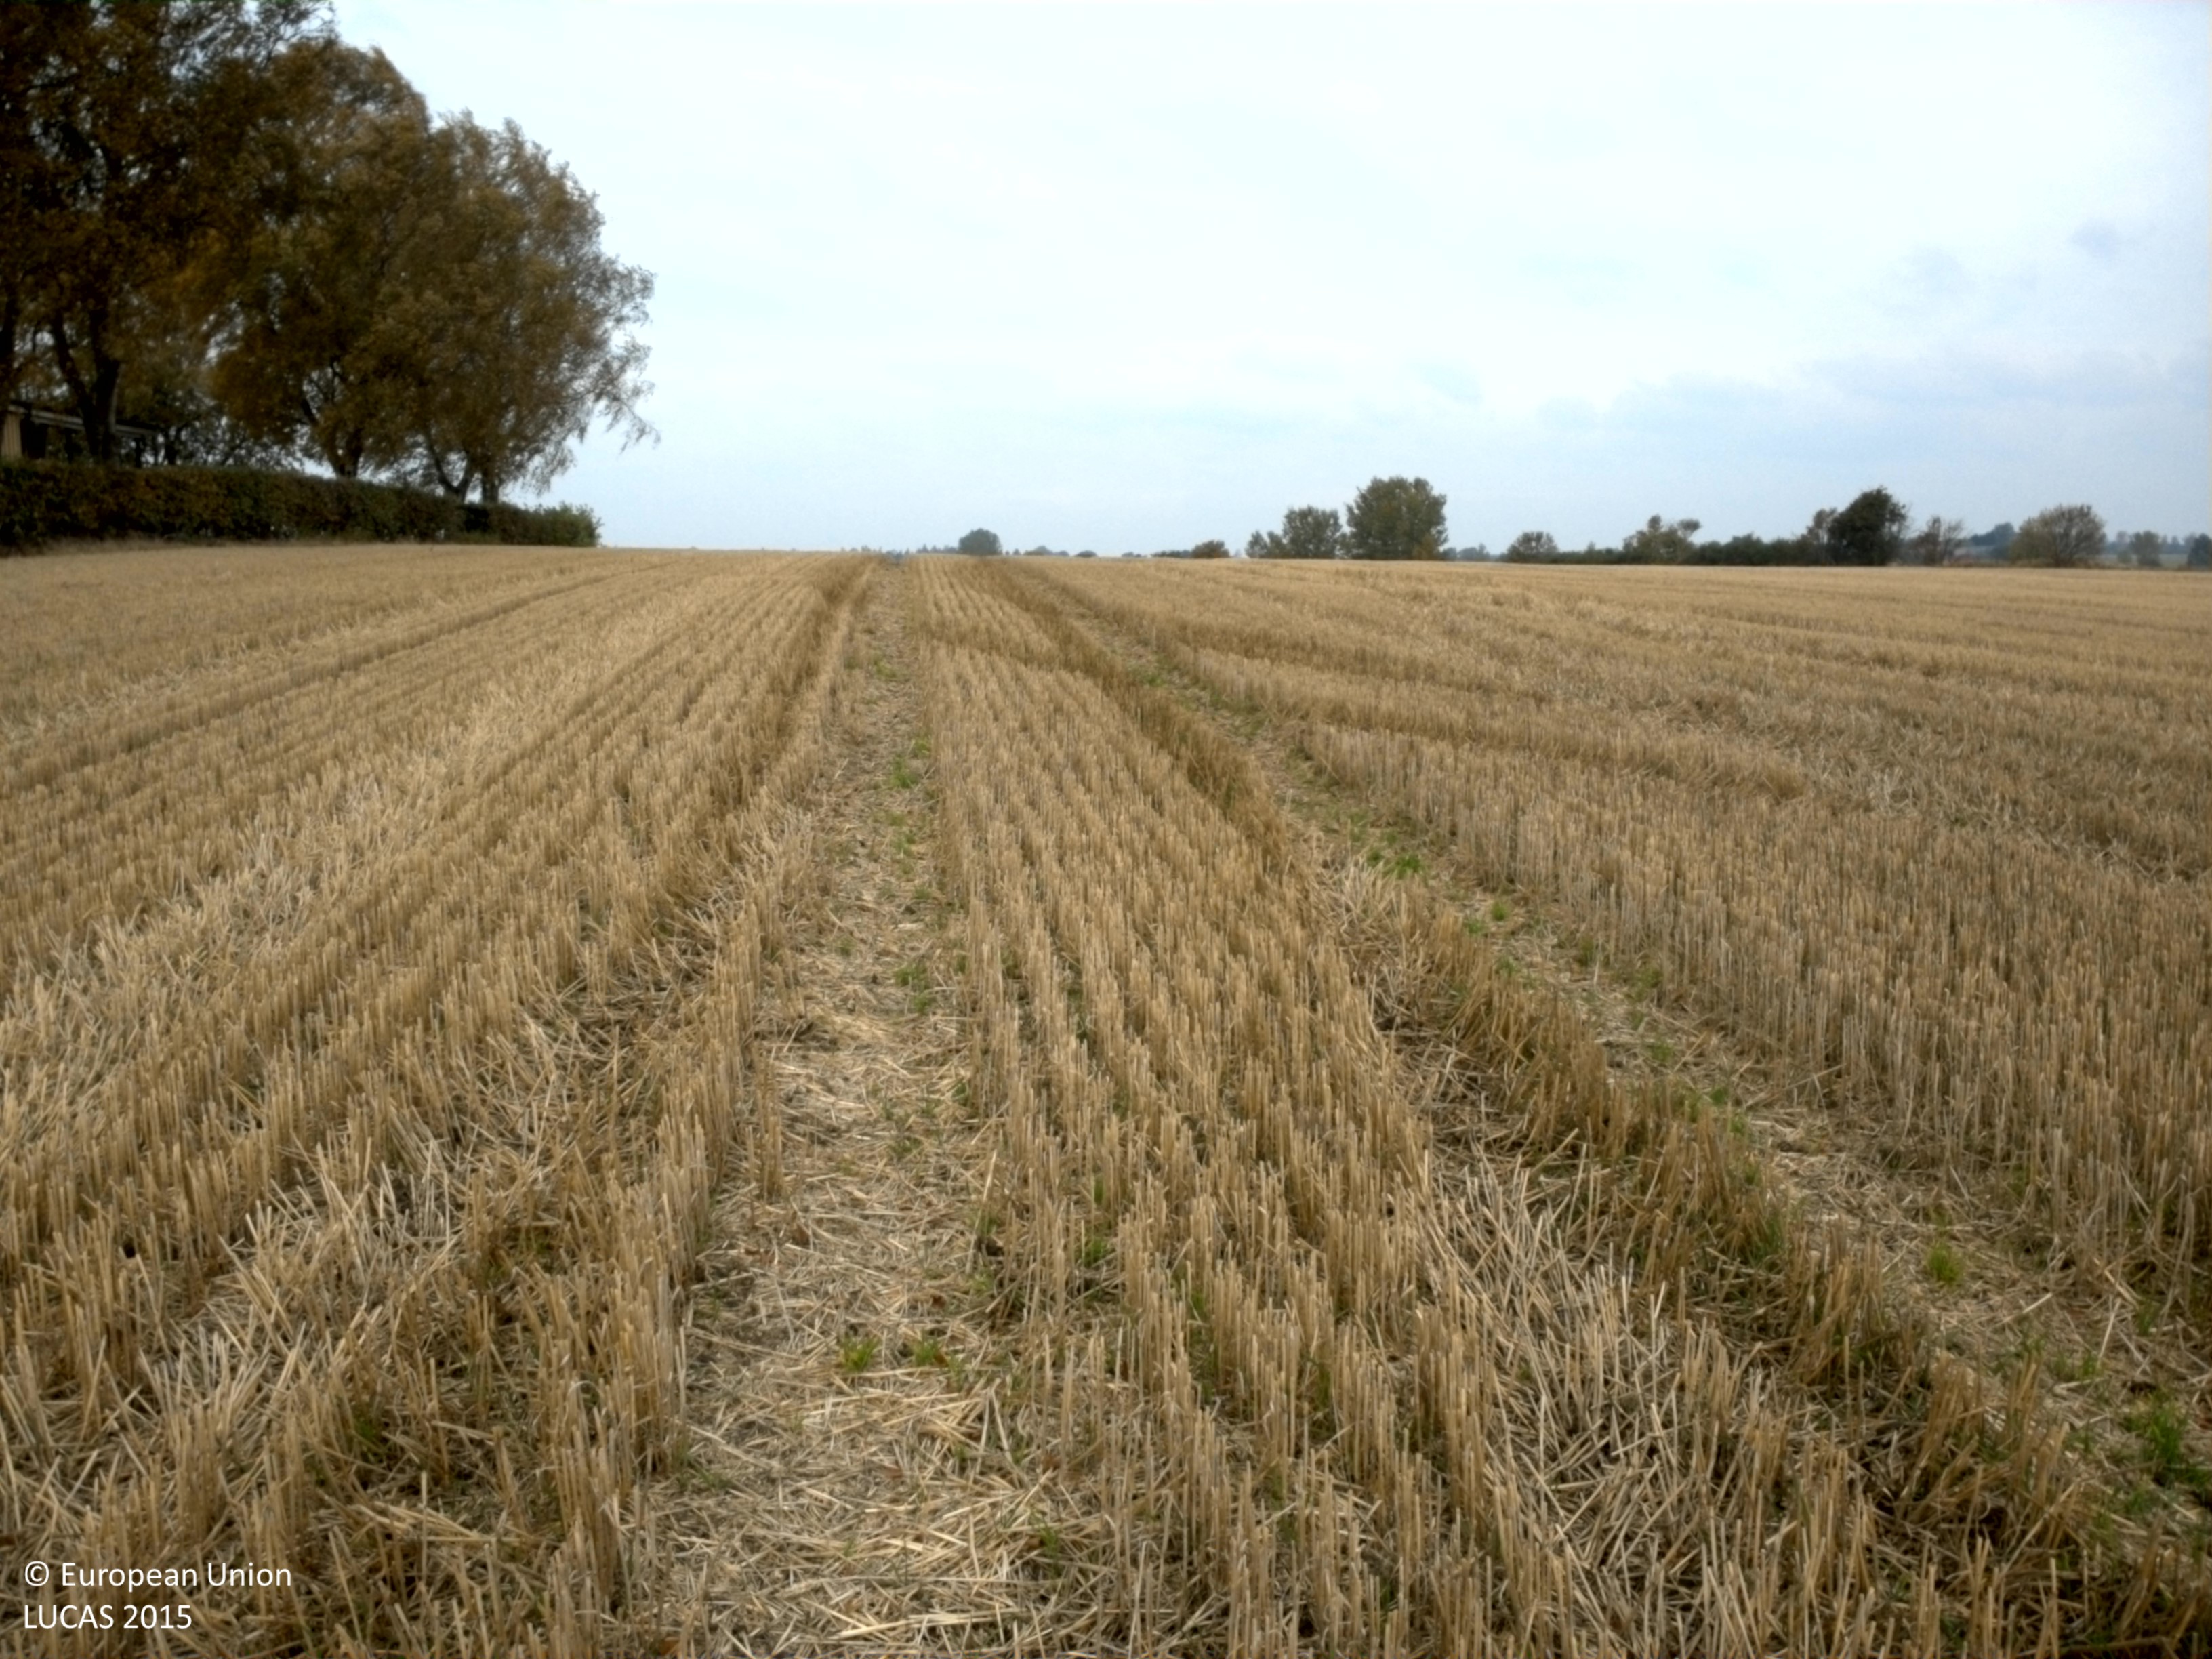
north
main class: Cropland
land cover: Common wheat
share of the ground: 10 - 25 %
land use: Agriculture (excluding fallow land and kitchen gardens)
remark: Harvested field
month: October
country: SE
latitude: 55.9153
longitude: 13.1496
